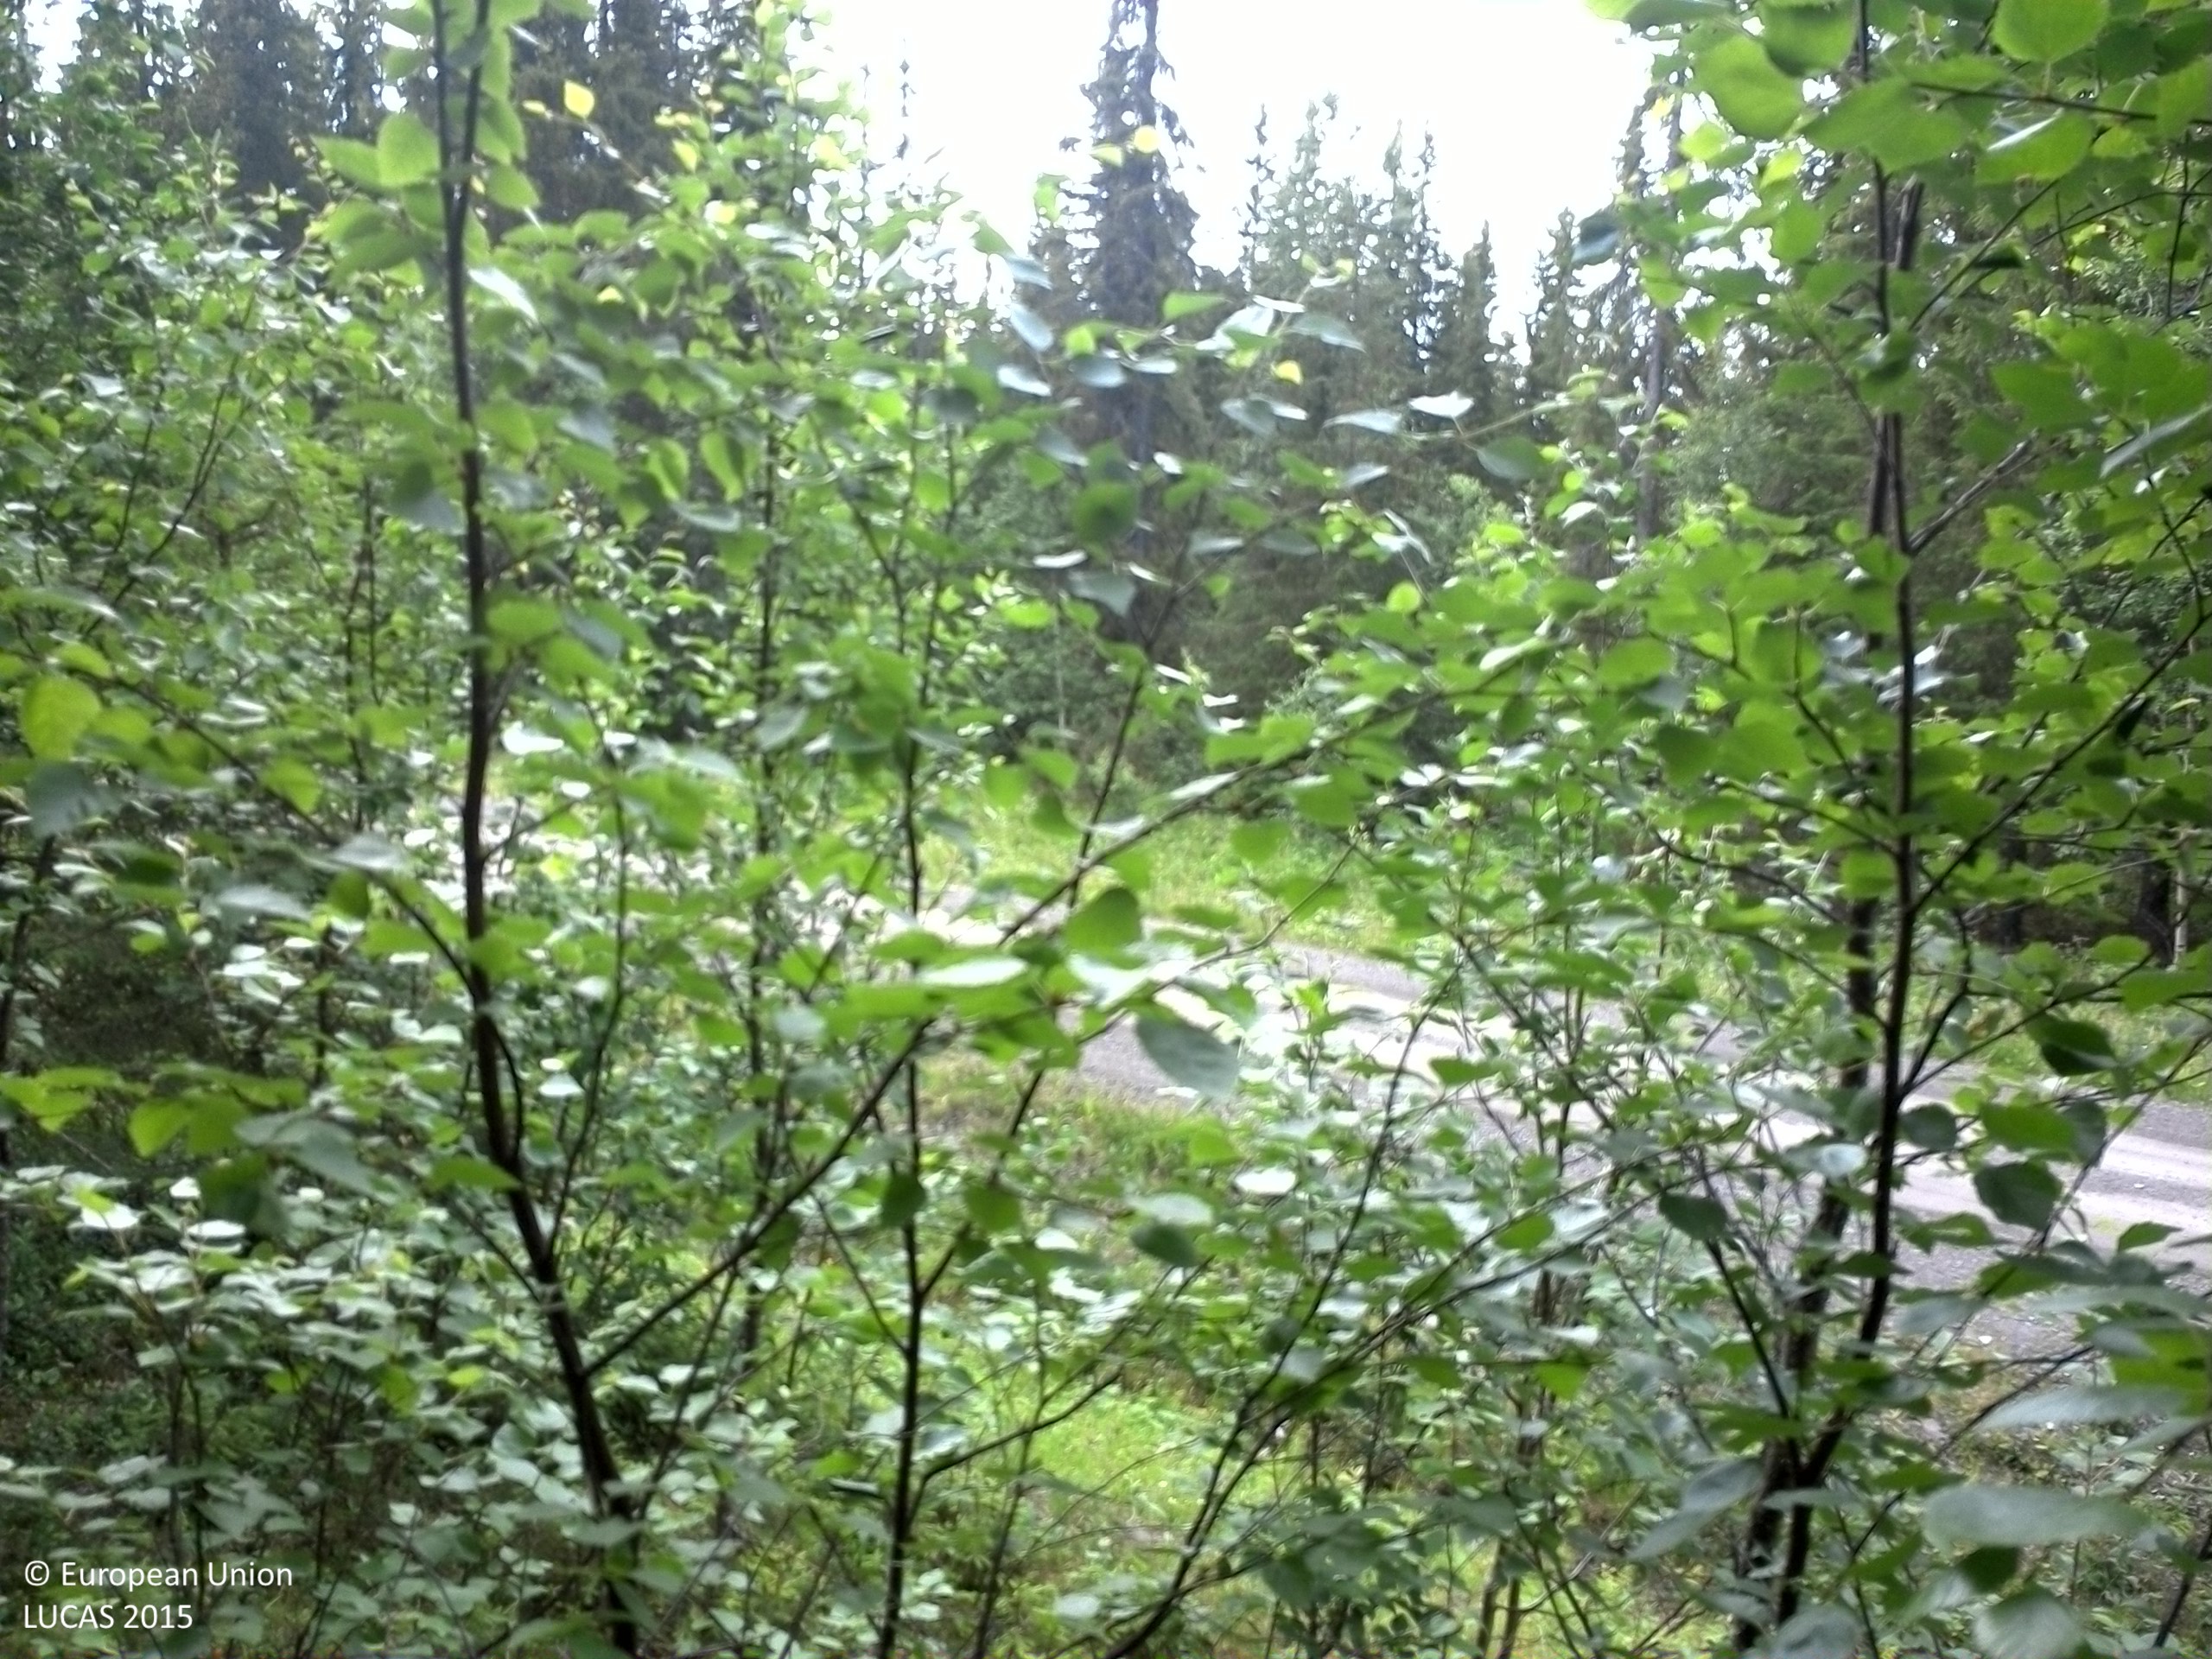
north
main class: Woodland
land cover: Spruce dominated coniferous woodland
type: boreal forest
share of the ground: 50 - 75 %
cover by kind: coniferous forest trees 60 %, shrubs 30 %, broadleaved forest trees 5 %, herbaceous plants 5 %
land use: Forestry
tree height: > 5 m
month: July
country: SE
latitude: 64.4127
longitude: 15.9668
